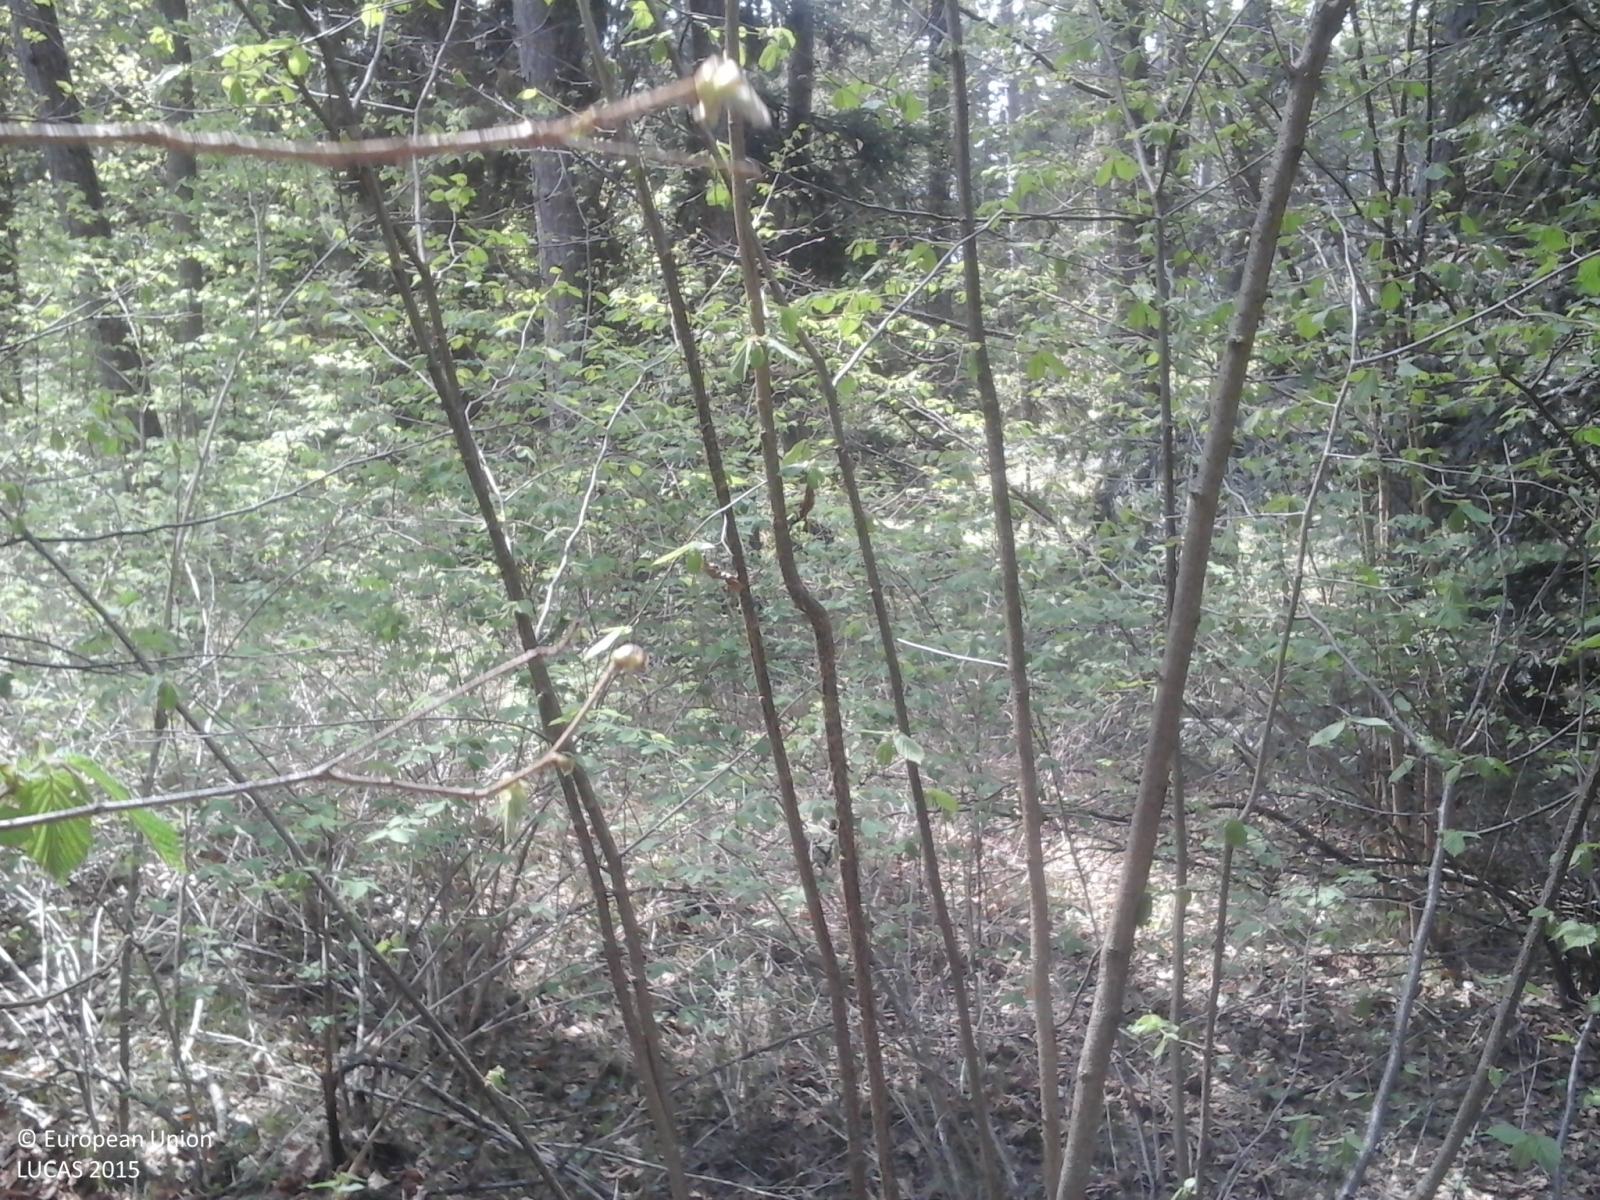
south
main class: Woodland
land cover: Spruce dominated coniferous woodland
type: alpine coniferous forest
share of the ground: > 75 %
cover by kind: coniferous forest trees 95 %, broadleaved forest trees 5 %
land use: Forestry
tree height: > 5 m
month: April
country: IT
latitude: 46.3275
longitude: 11.1026
